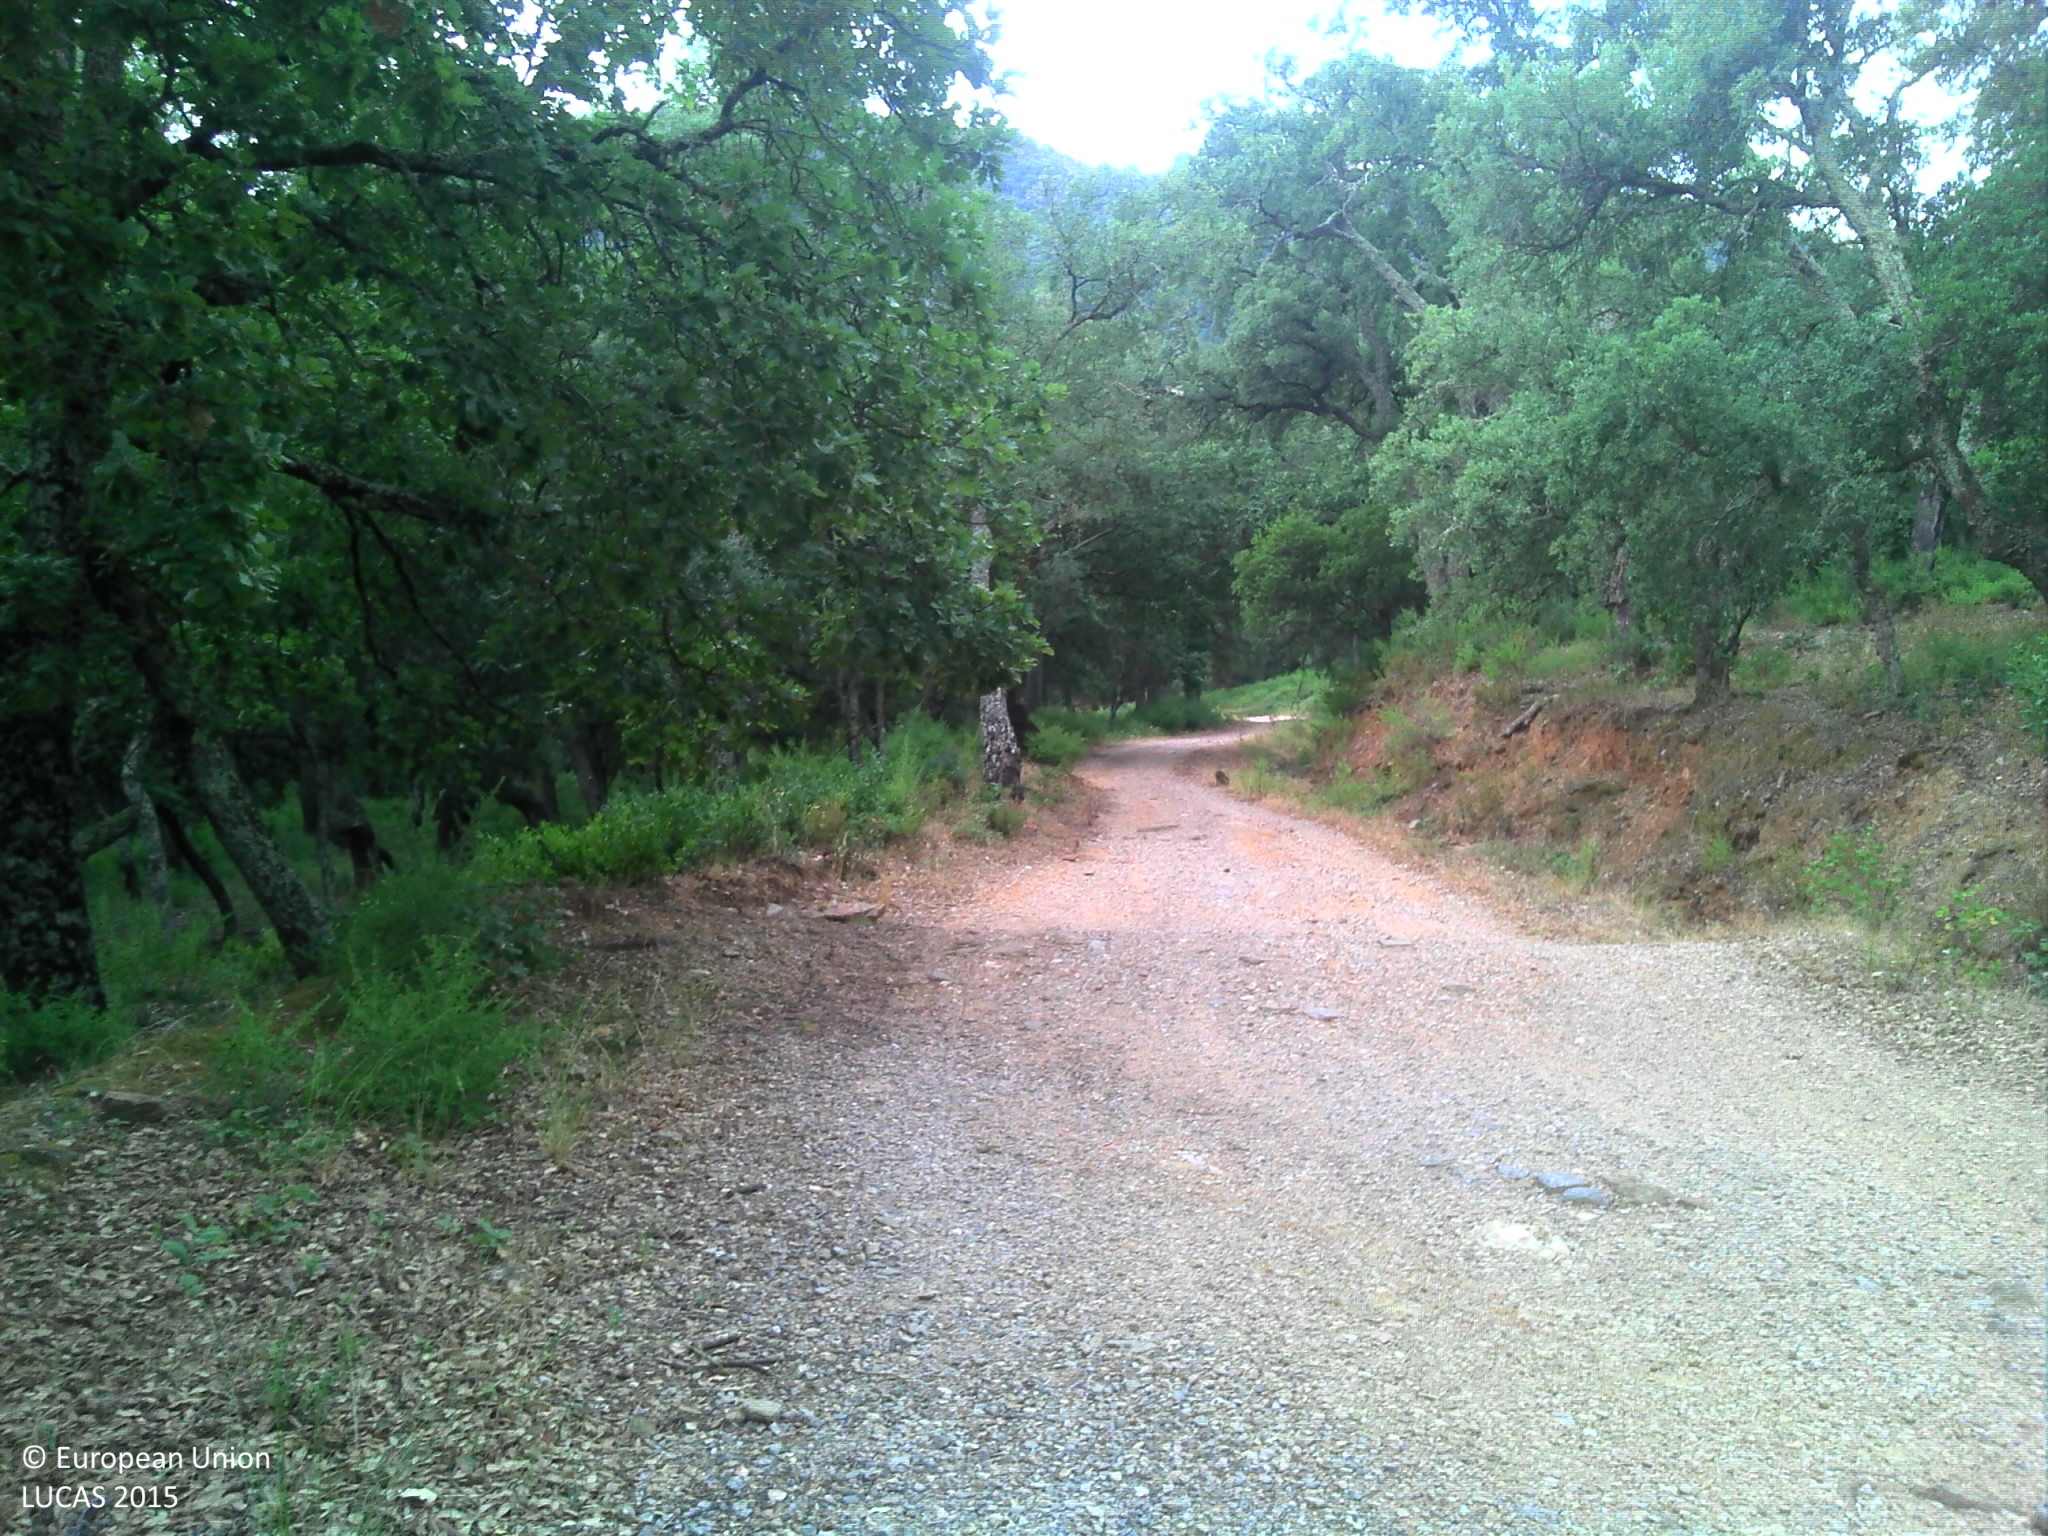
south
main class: Woodland
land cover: Broadleaved woodland
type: thermophilous deciduous forest
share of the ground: > 75 %
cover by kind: broadleaved forest trees 90 %, shrubs 10 %
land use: Forestry
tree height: > 5 m
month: July
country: FR
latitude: 43.3128
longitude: 6.3965
